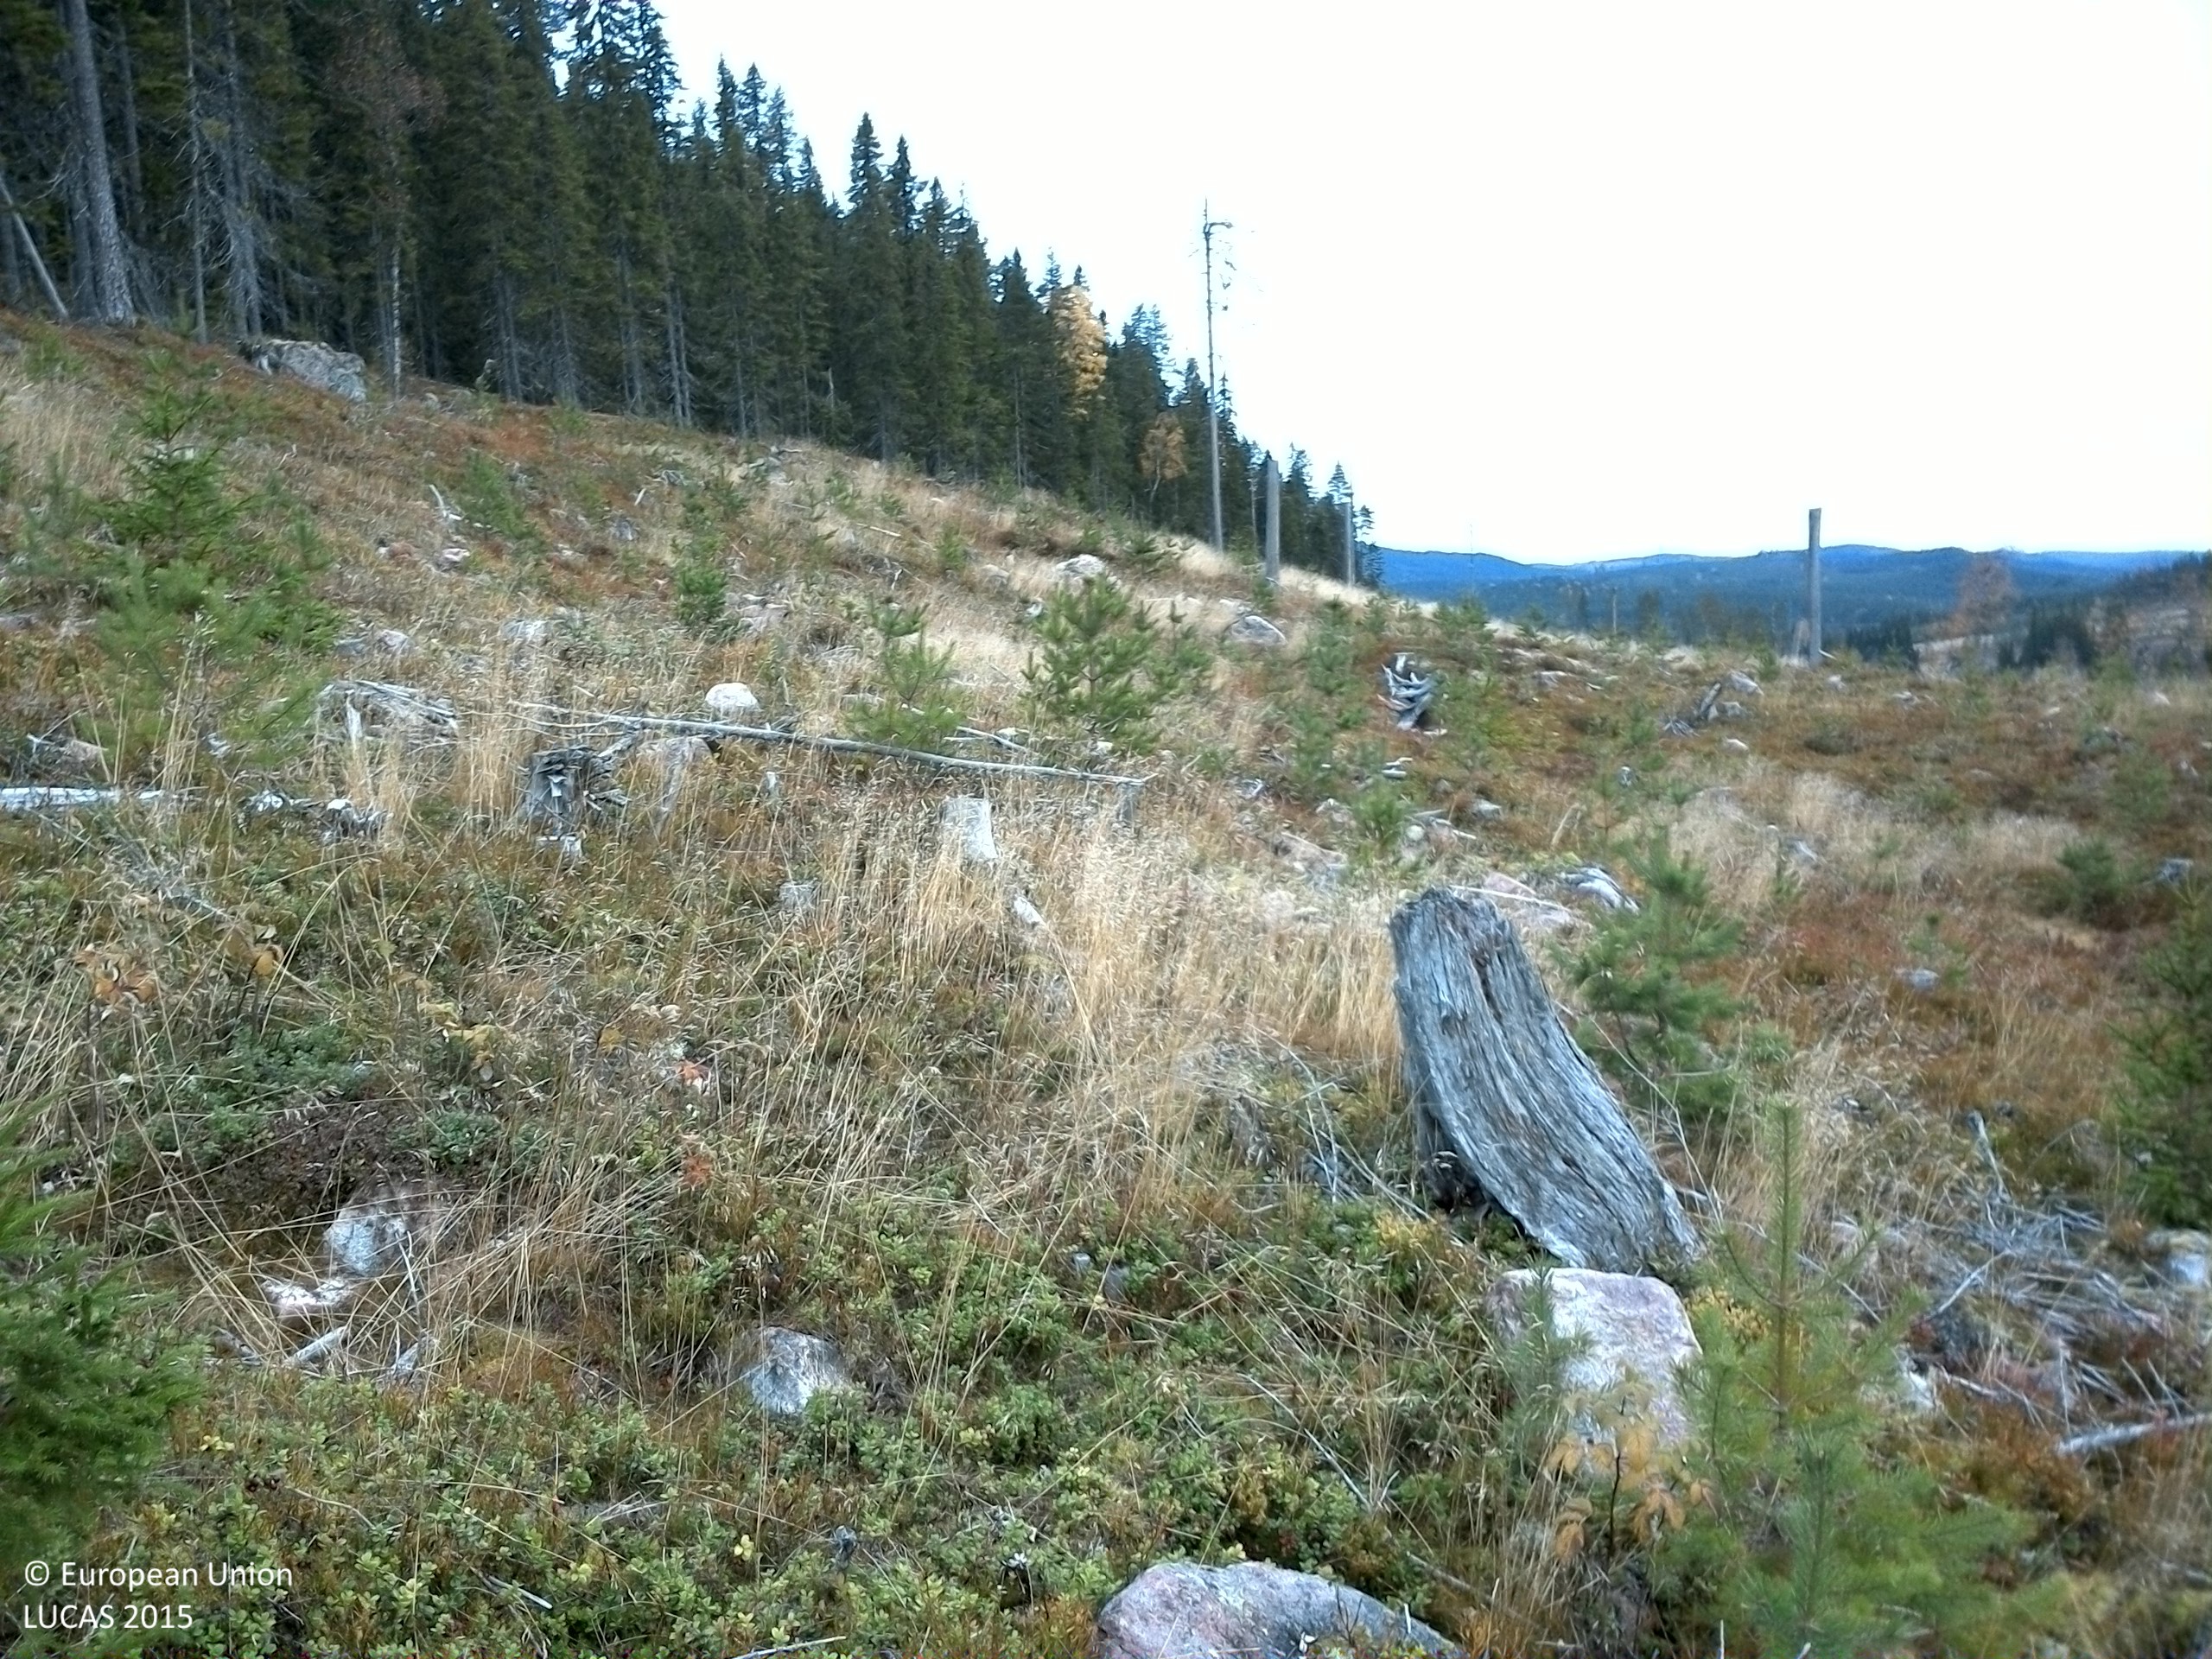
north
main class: Woodland
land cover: Pine dominated coniferous woodland
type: boreal forest
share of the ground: 25 - 50 %
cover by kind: shrubs 55 %, coniferous forest trees 25 %, herbaceous plants 10 %, lichens and mosses 10 %
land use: Forestry
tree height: < 5 m
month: October
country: SE
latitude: 61.2674
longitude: 14.3683
